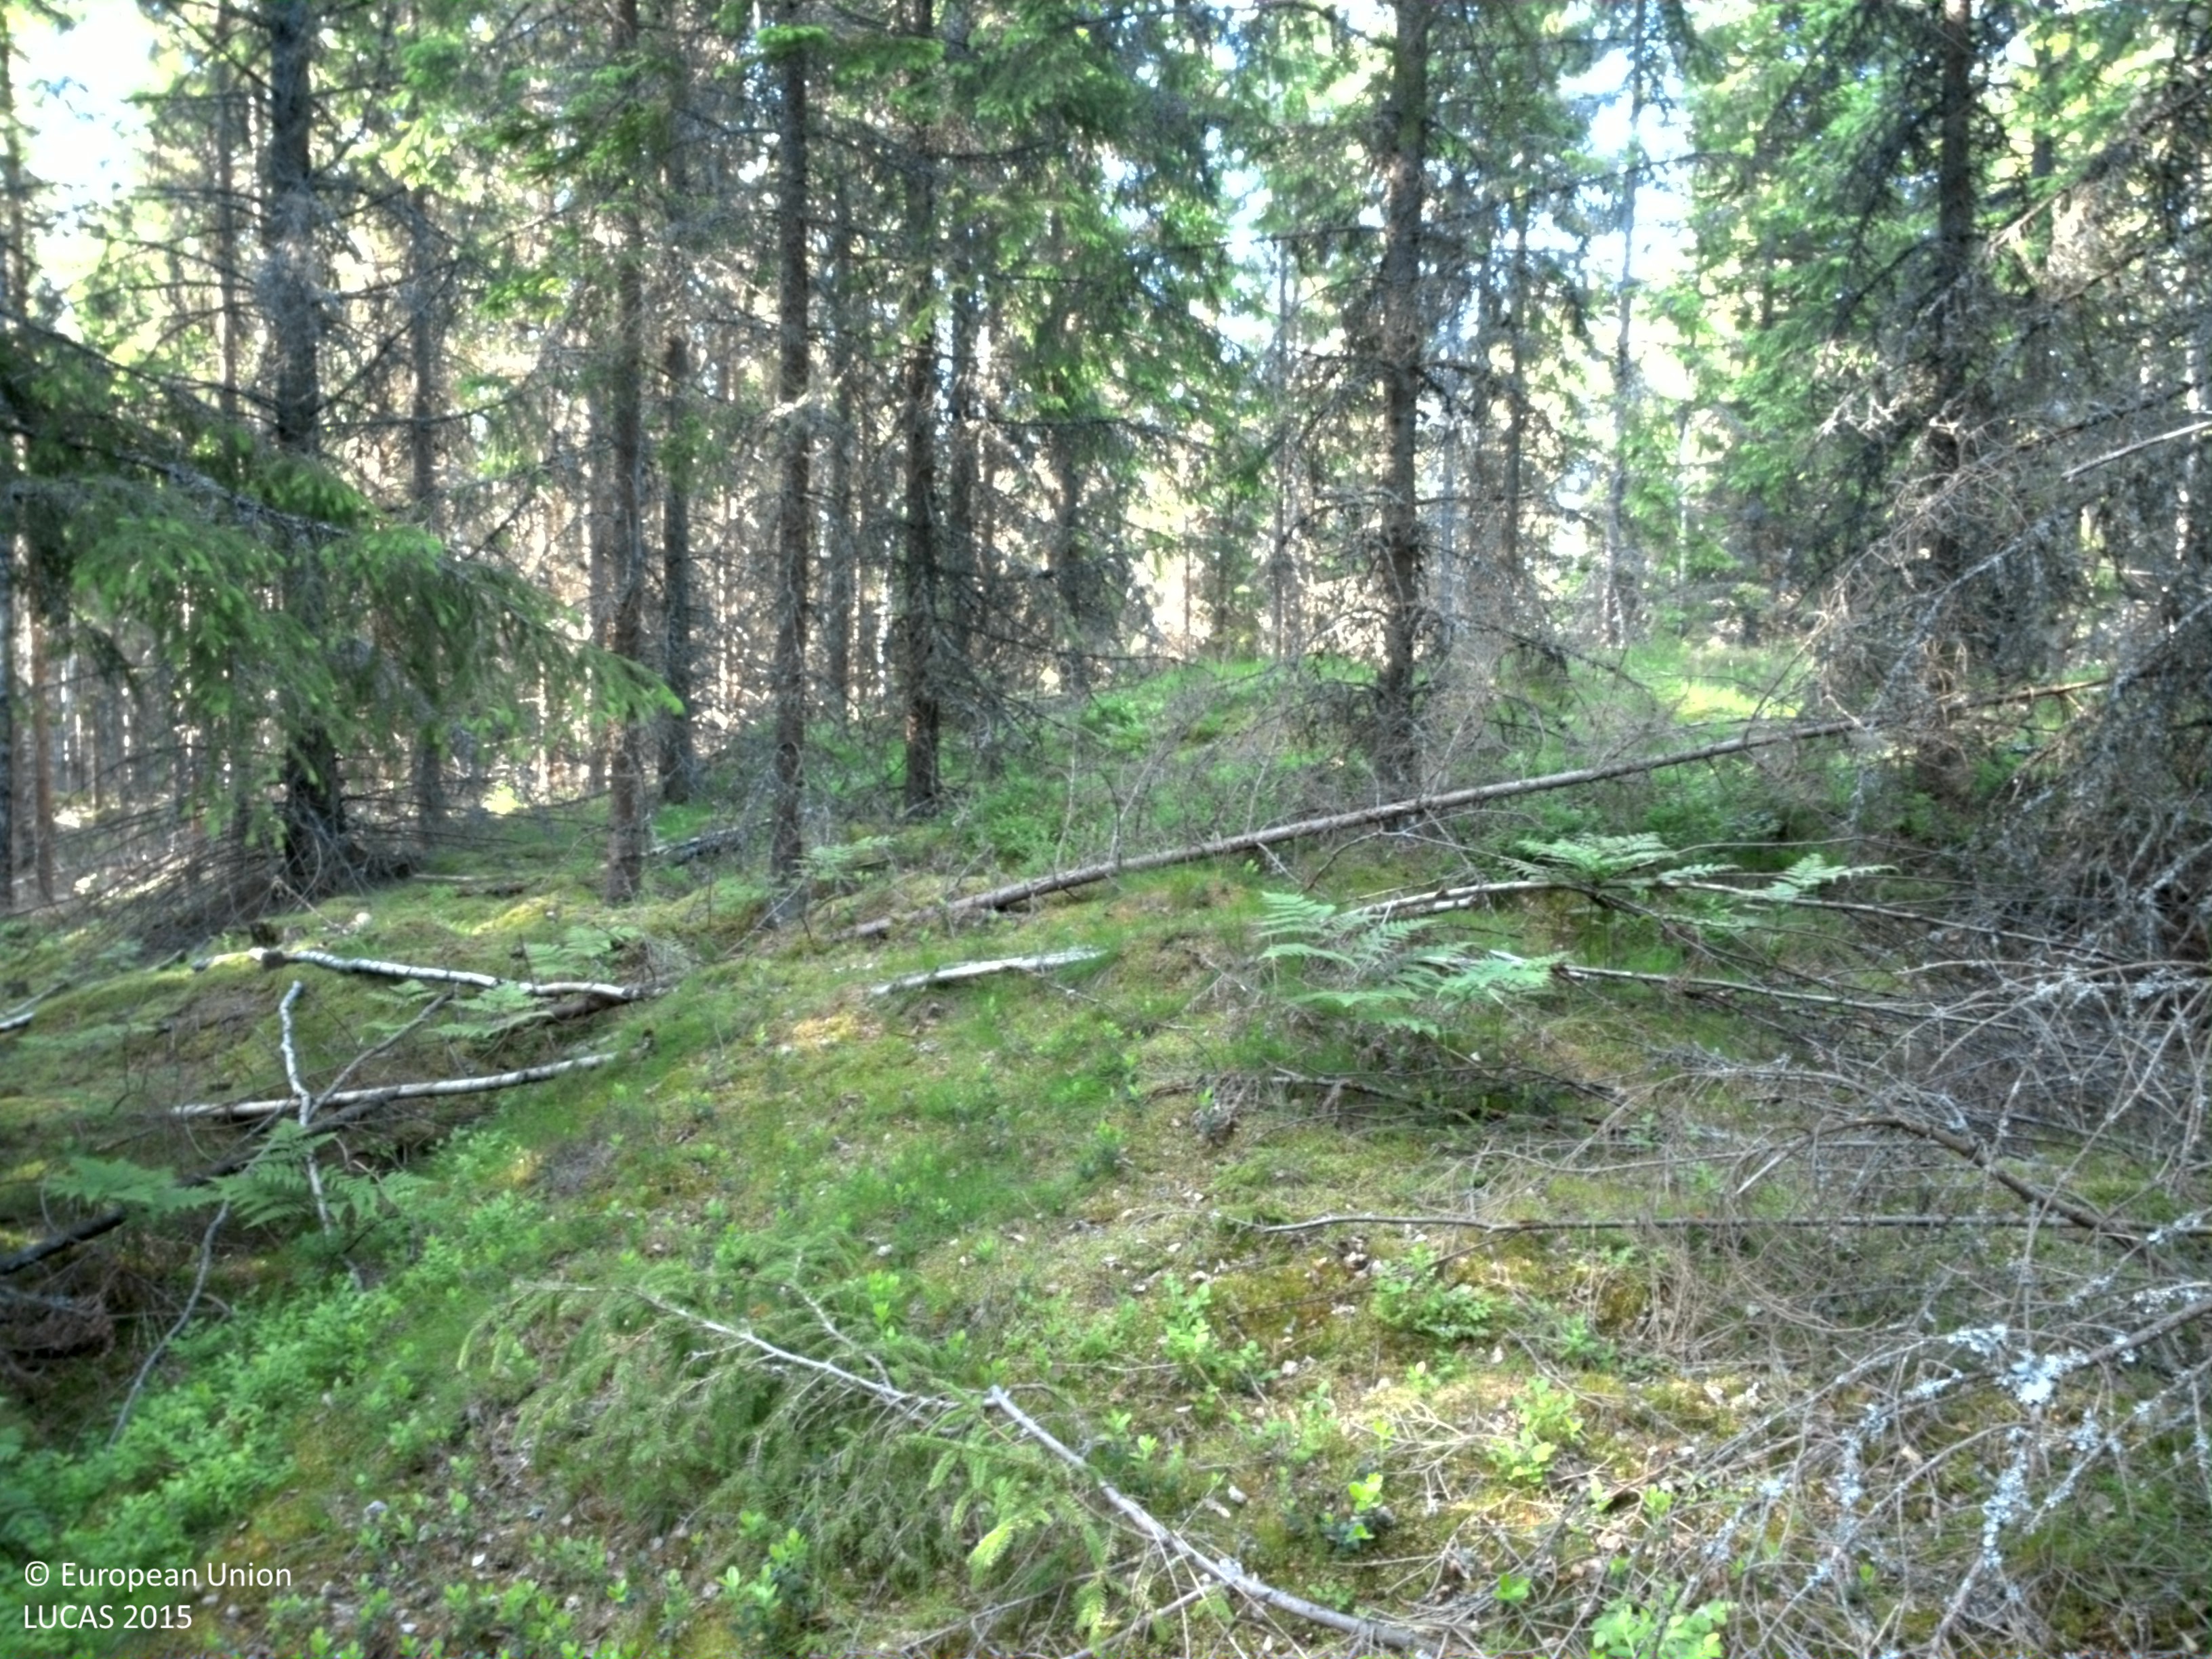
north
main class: Woodland
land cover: Spruce dominated coniferous woodland
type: boreal forest
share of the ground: 50 - 75 %
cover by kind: coniferous forest trees 65 %, lichens and mosses 20 %, broadleaved forest trees 10 %, shrubs 5 %
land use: Forestry
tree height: > 5 m
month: June
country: SE
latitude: 58.6154
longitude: 14.4177
